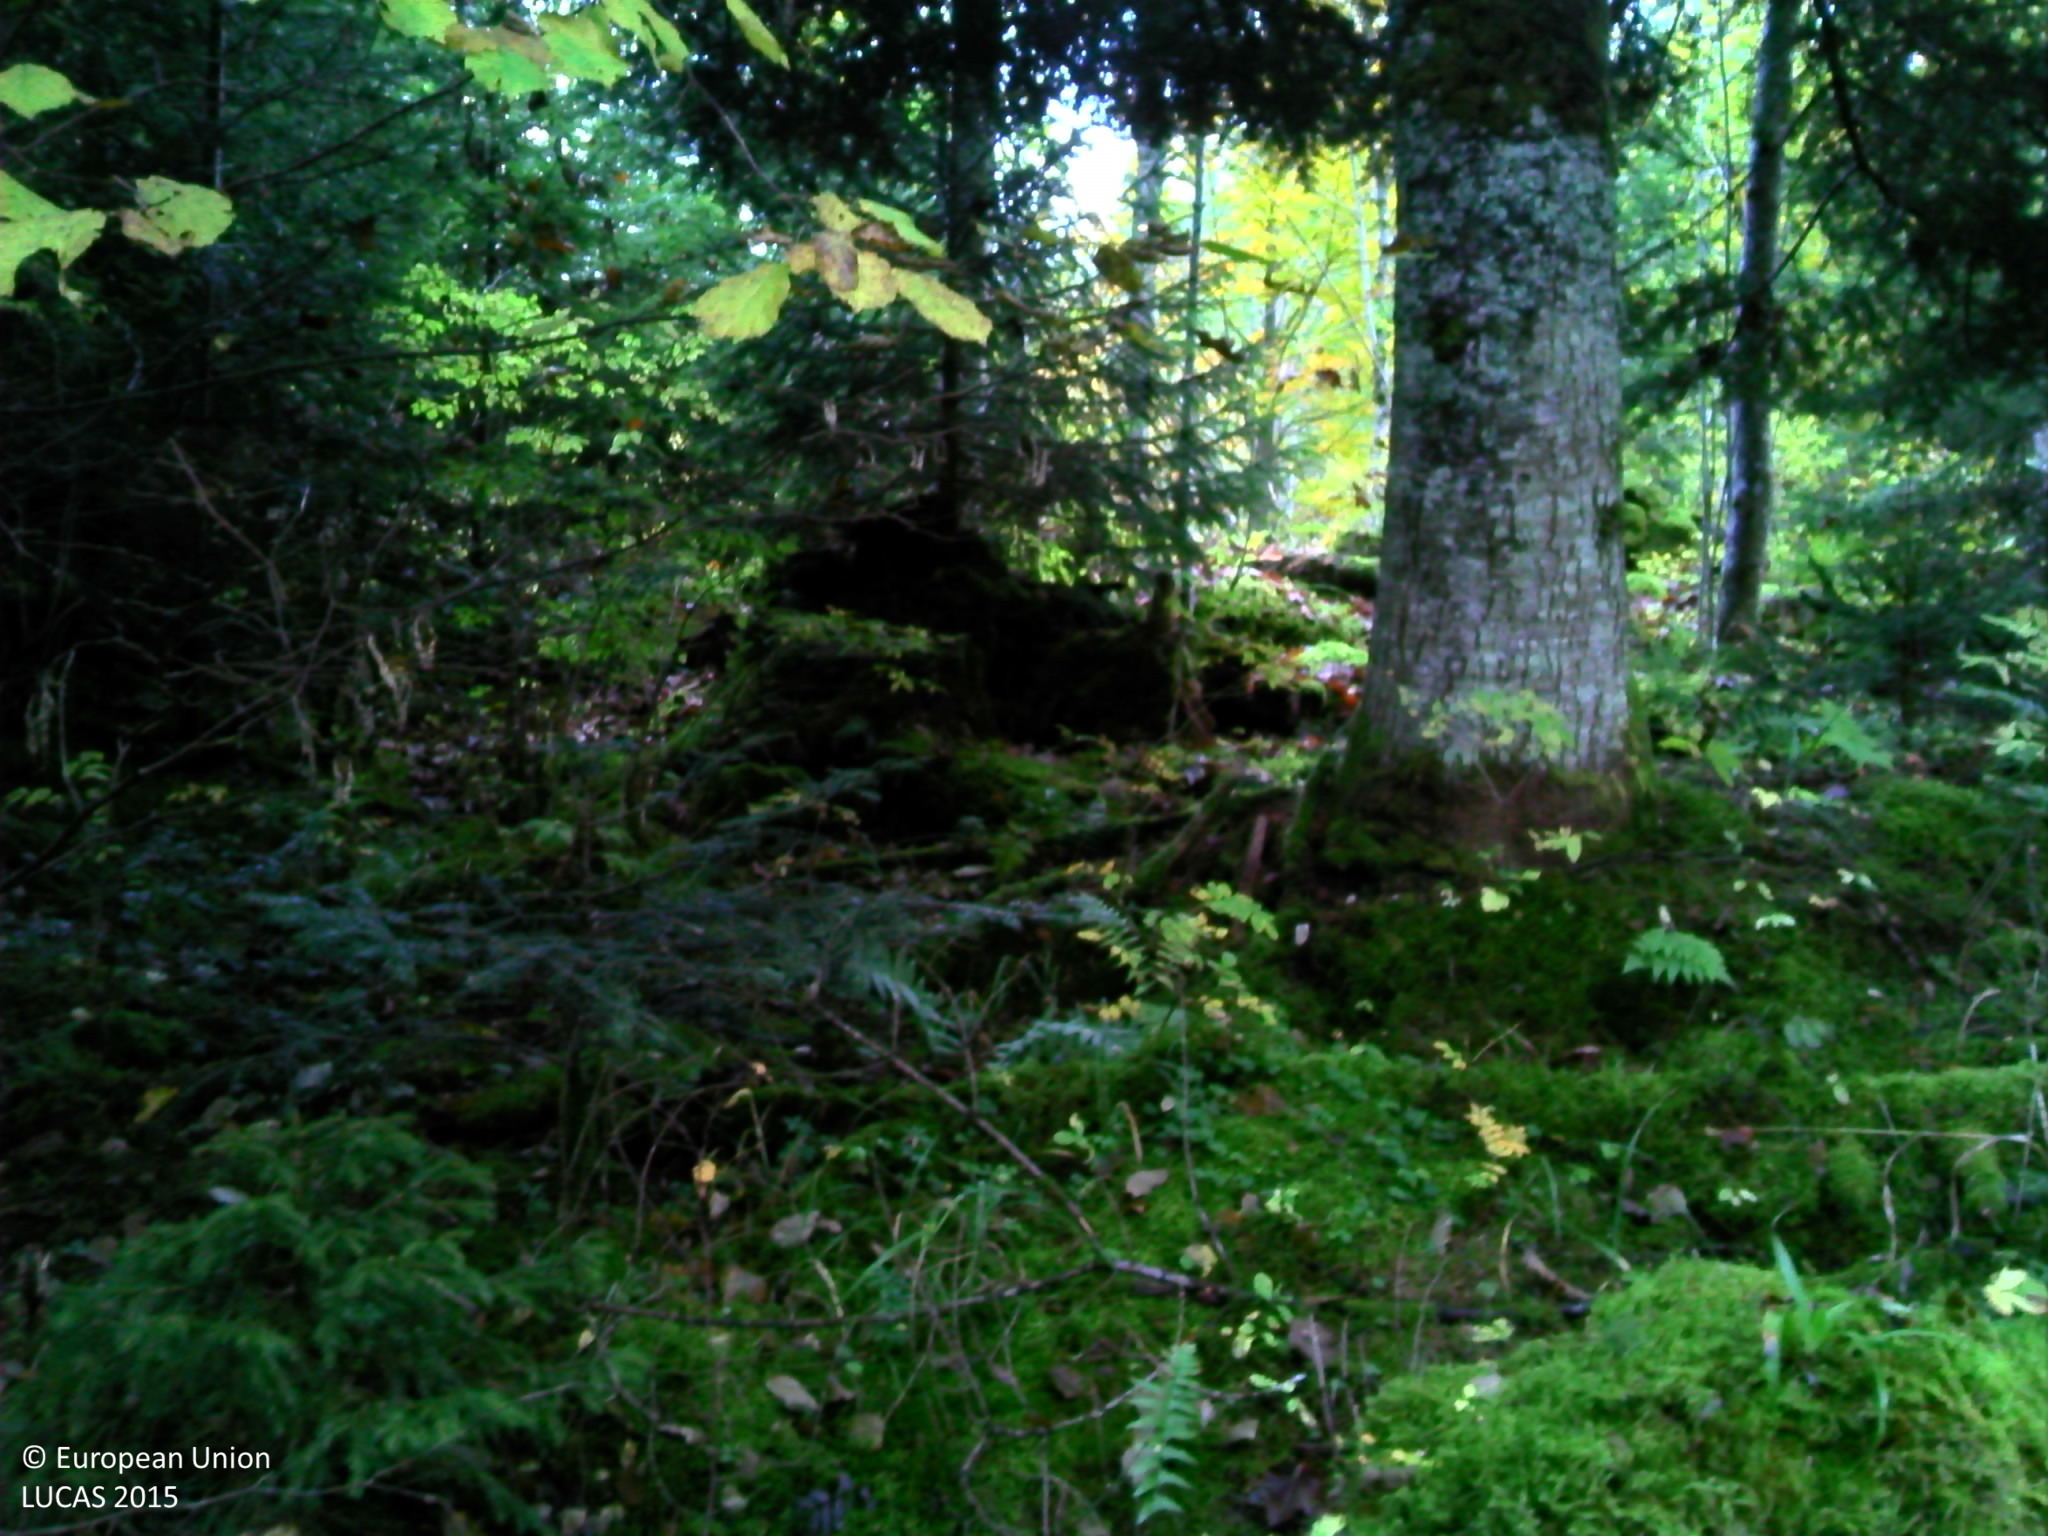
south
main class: Woodland
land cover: Spruce dominated mixed woodland
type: hemiboreal forest and nemoral coniferous forest and mixed broadleaved-coniferous forest
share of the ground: > 75 %
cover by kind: coniferous forest trees 40 %, broadleaved forest trees 40 %, shrubs 20 %
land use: Forestry
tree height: > 5 m
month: October
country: FR
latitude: 46.7927
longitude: 6.3213
